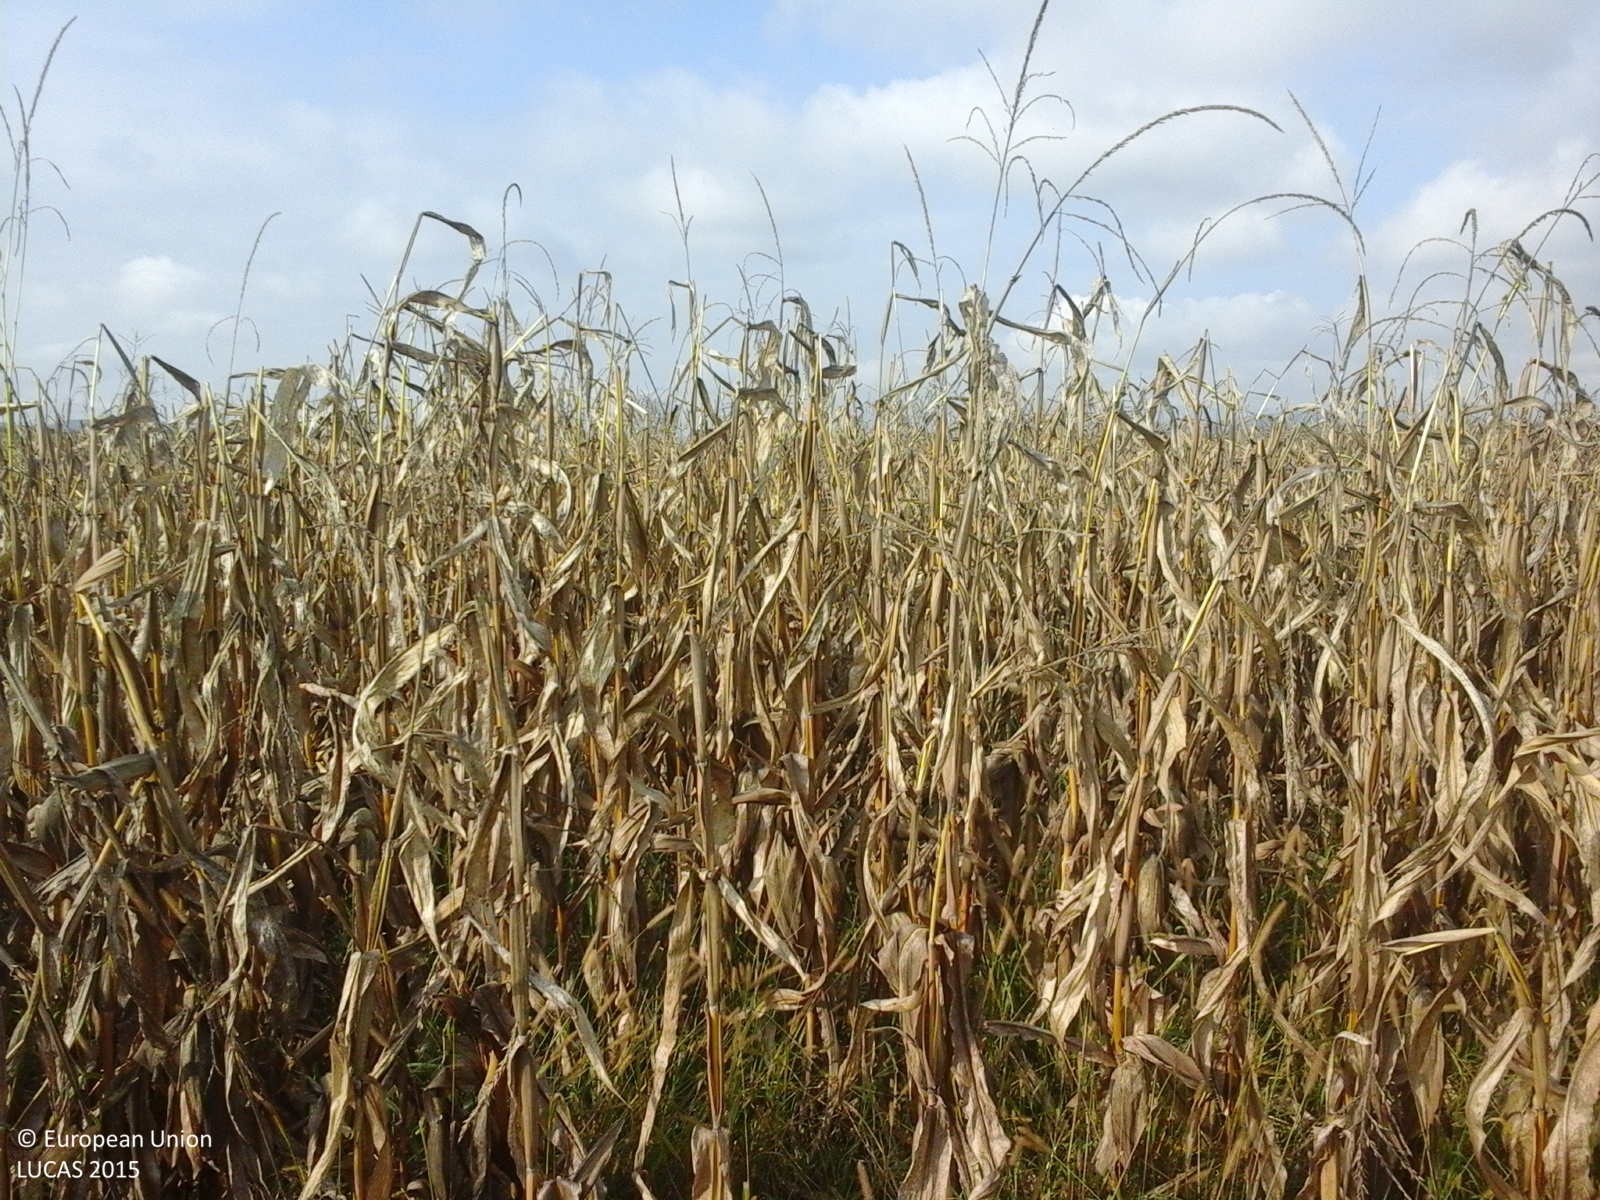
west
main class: Cropland
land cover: Maize
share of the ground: > 75 %
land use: Agriculture (excluding fallow land and kitchen gardens)
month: October
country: RO
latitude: 46.4170
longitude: 23.9577
